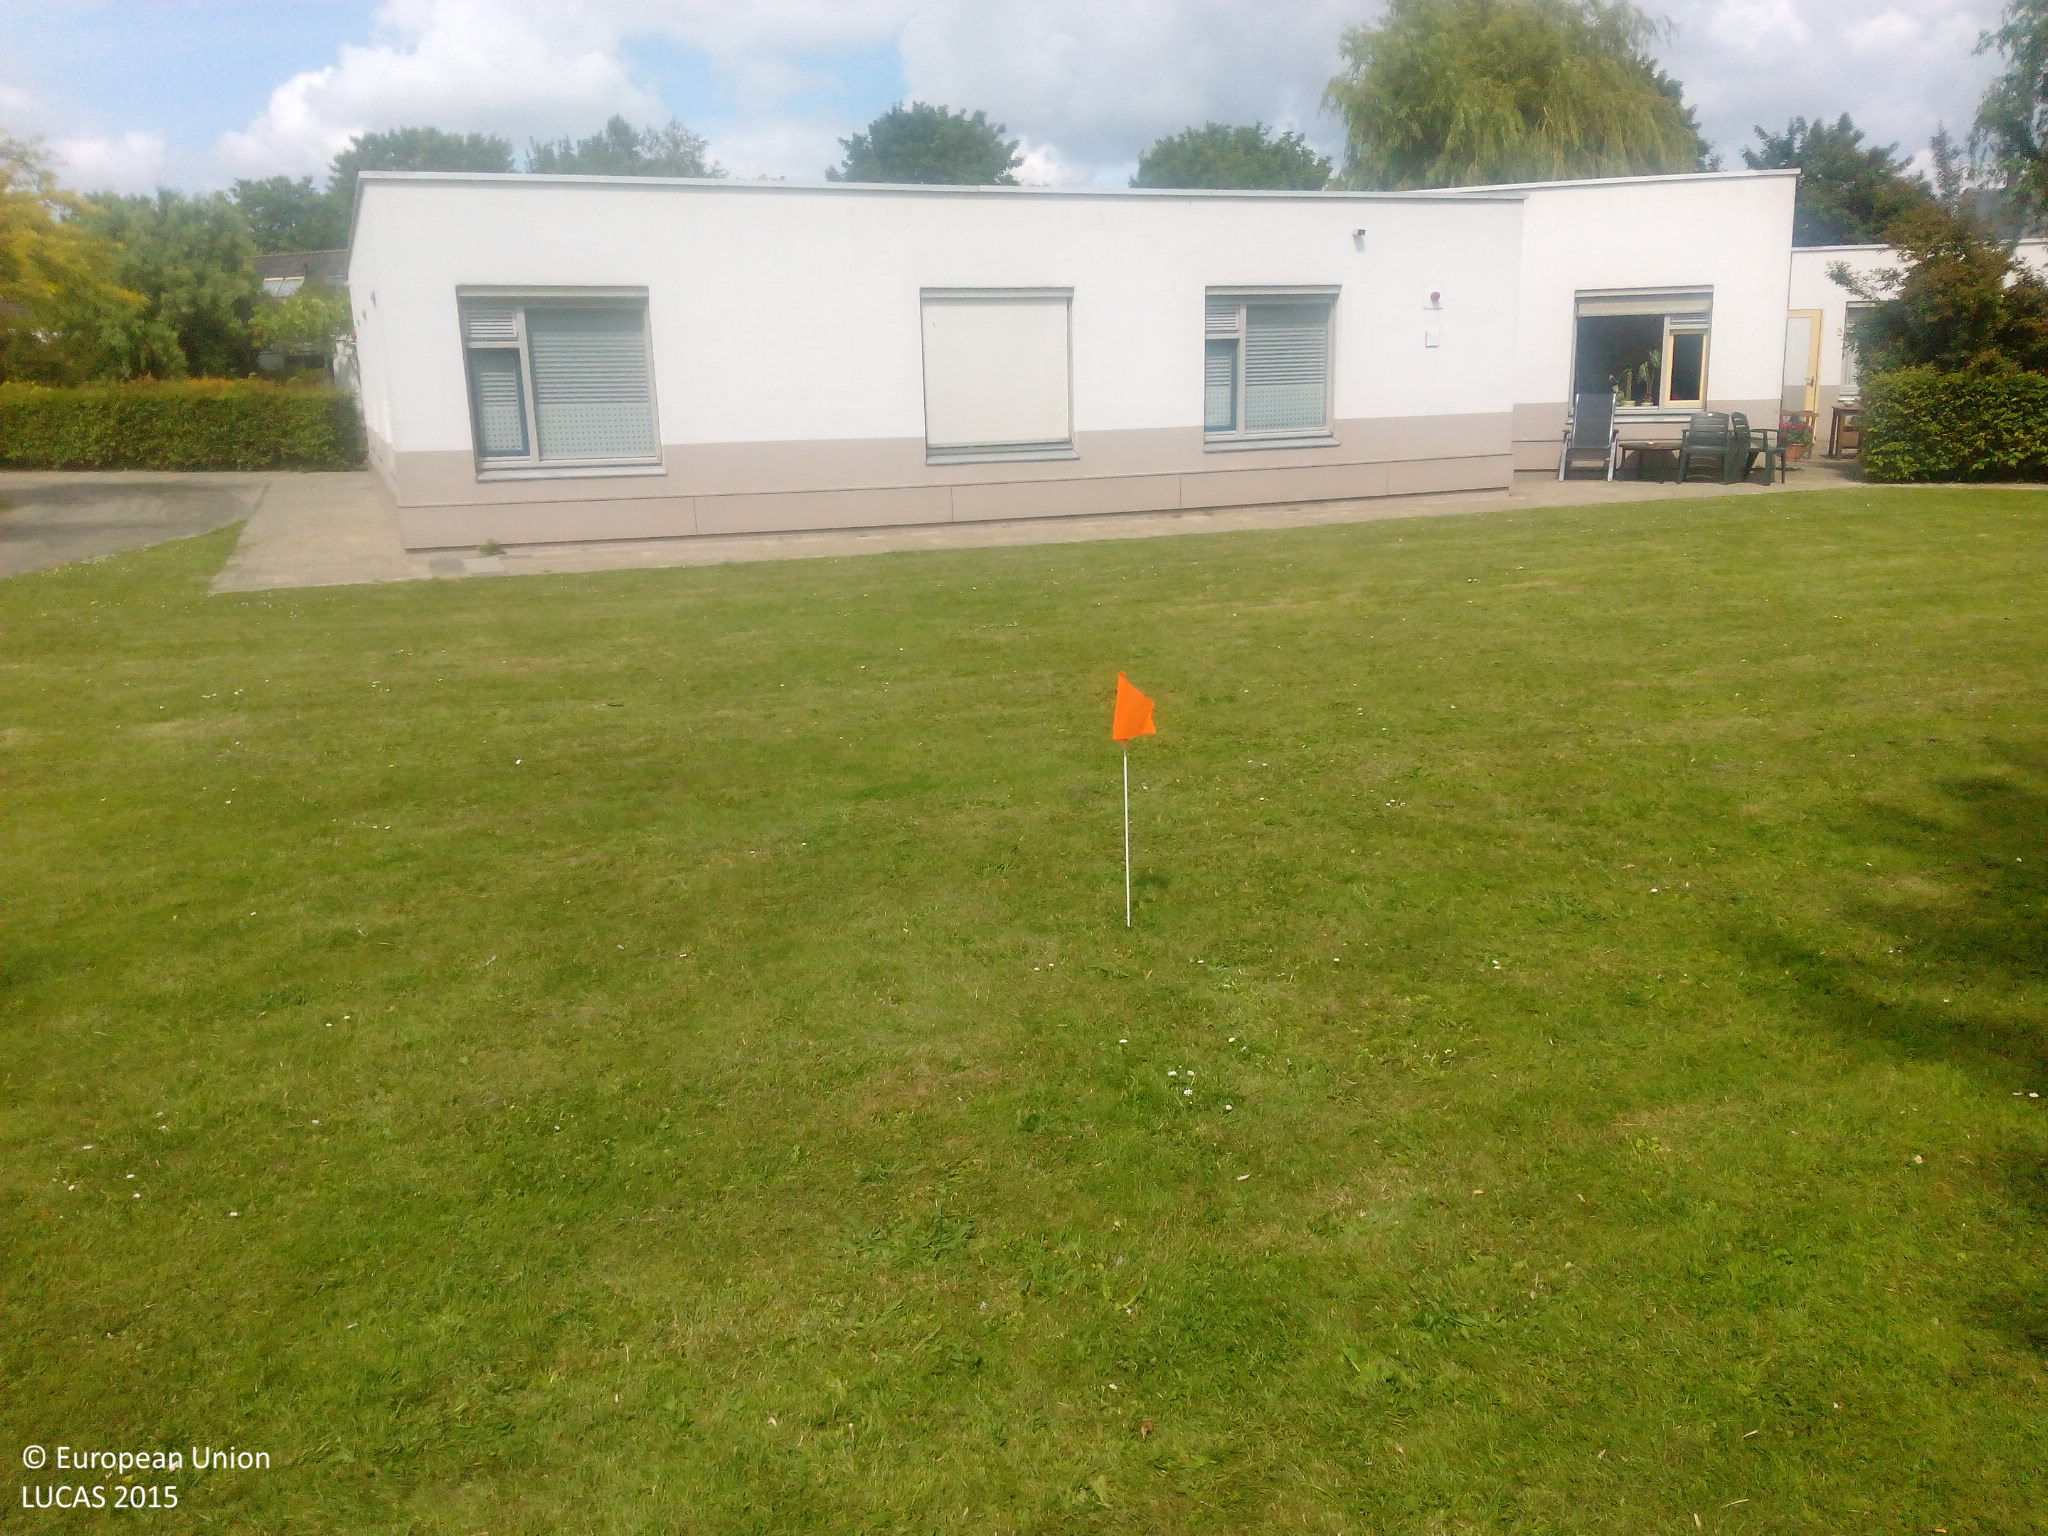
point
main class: Woodland
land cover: Broadleaved woodland
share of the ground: 25 - 50 %
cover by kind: herbaceous plants 55 %, broadleaved forest trees 30 %, consolidated bare surface 15 %
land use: Residential
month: June
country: NL
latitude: 51.8366
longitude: 4.1460
